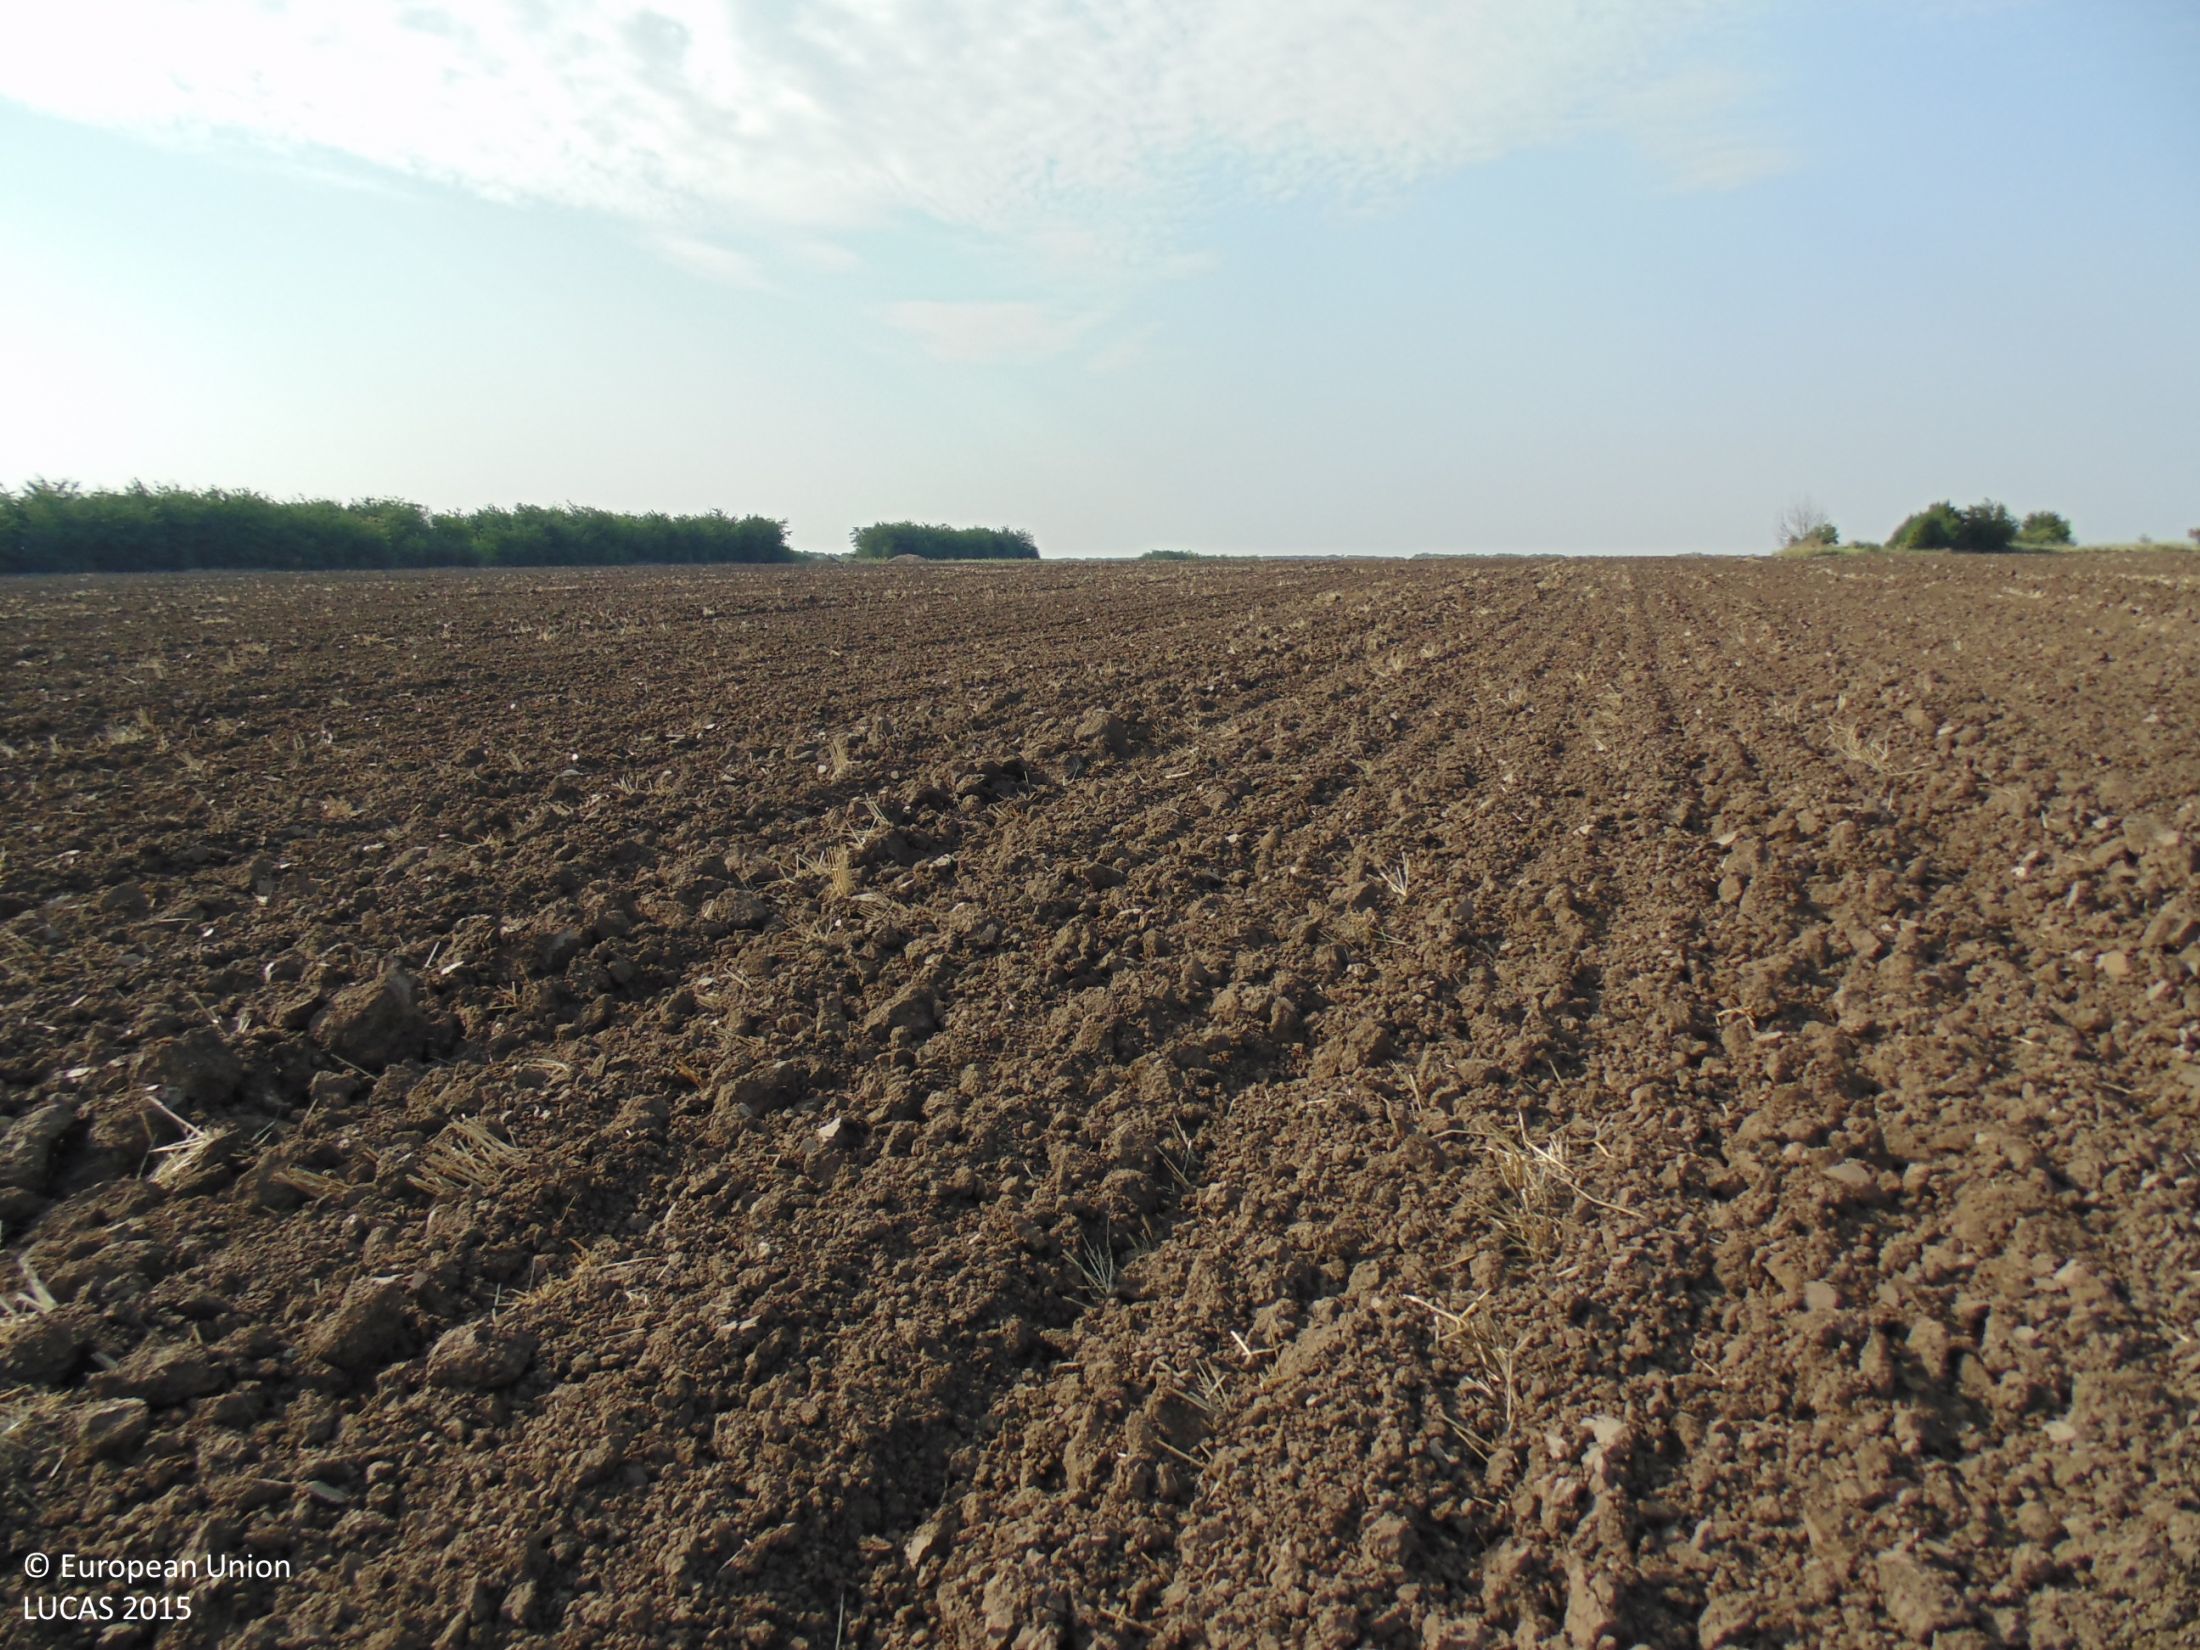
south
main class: Cropland
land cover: Common wheat
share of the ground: < 10 %
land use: Agriculture (excluding fallow land and kitchen gardens)
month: August
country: BG
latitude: 43.7168
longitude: 27.7025
